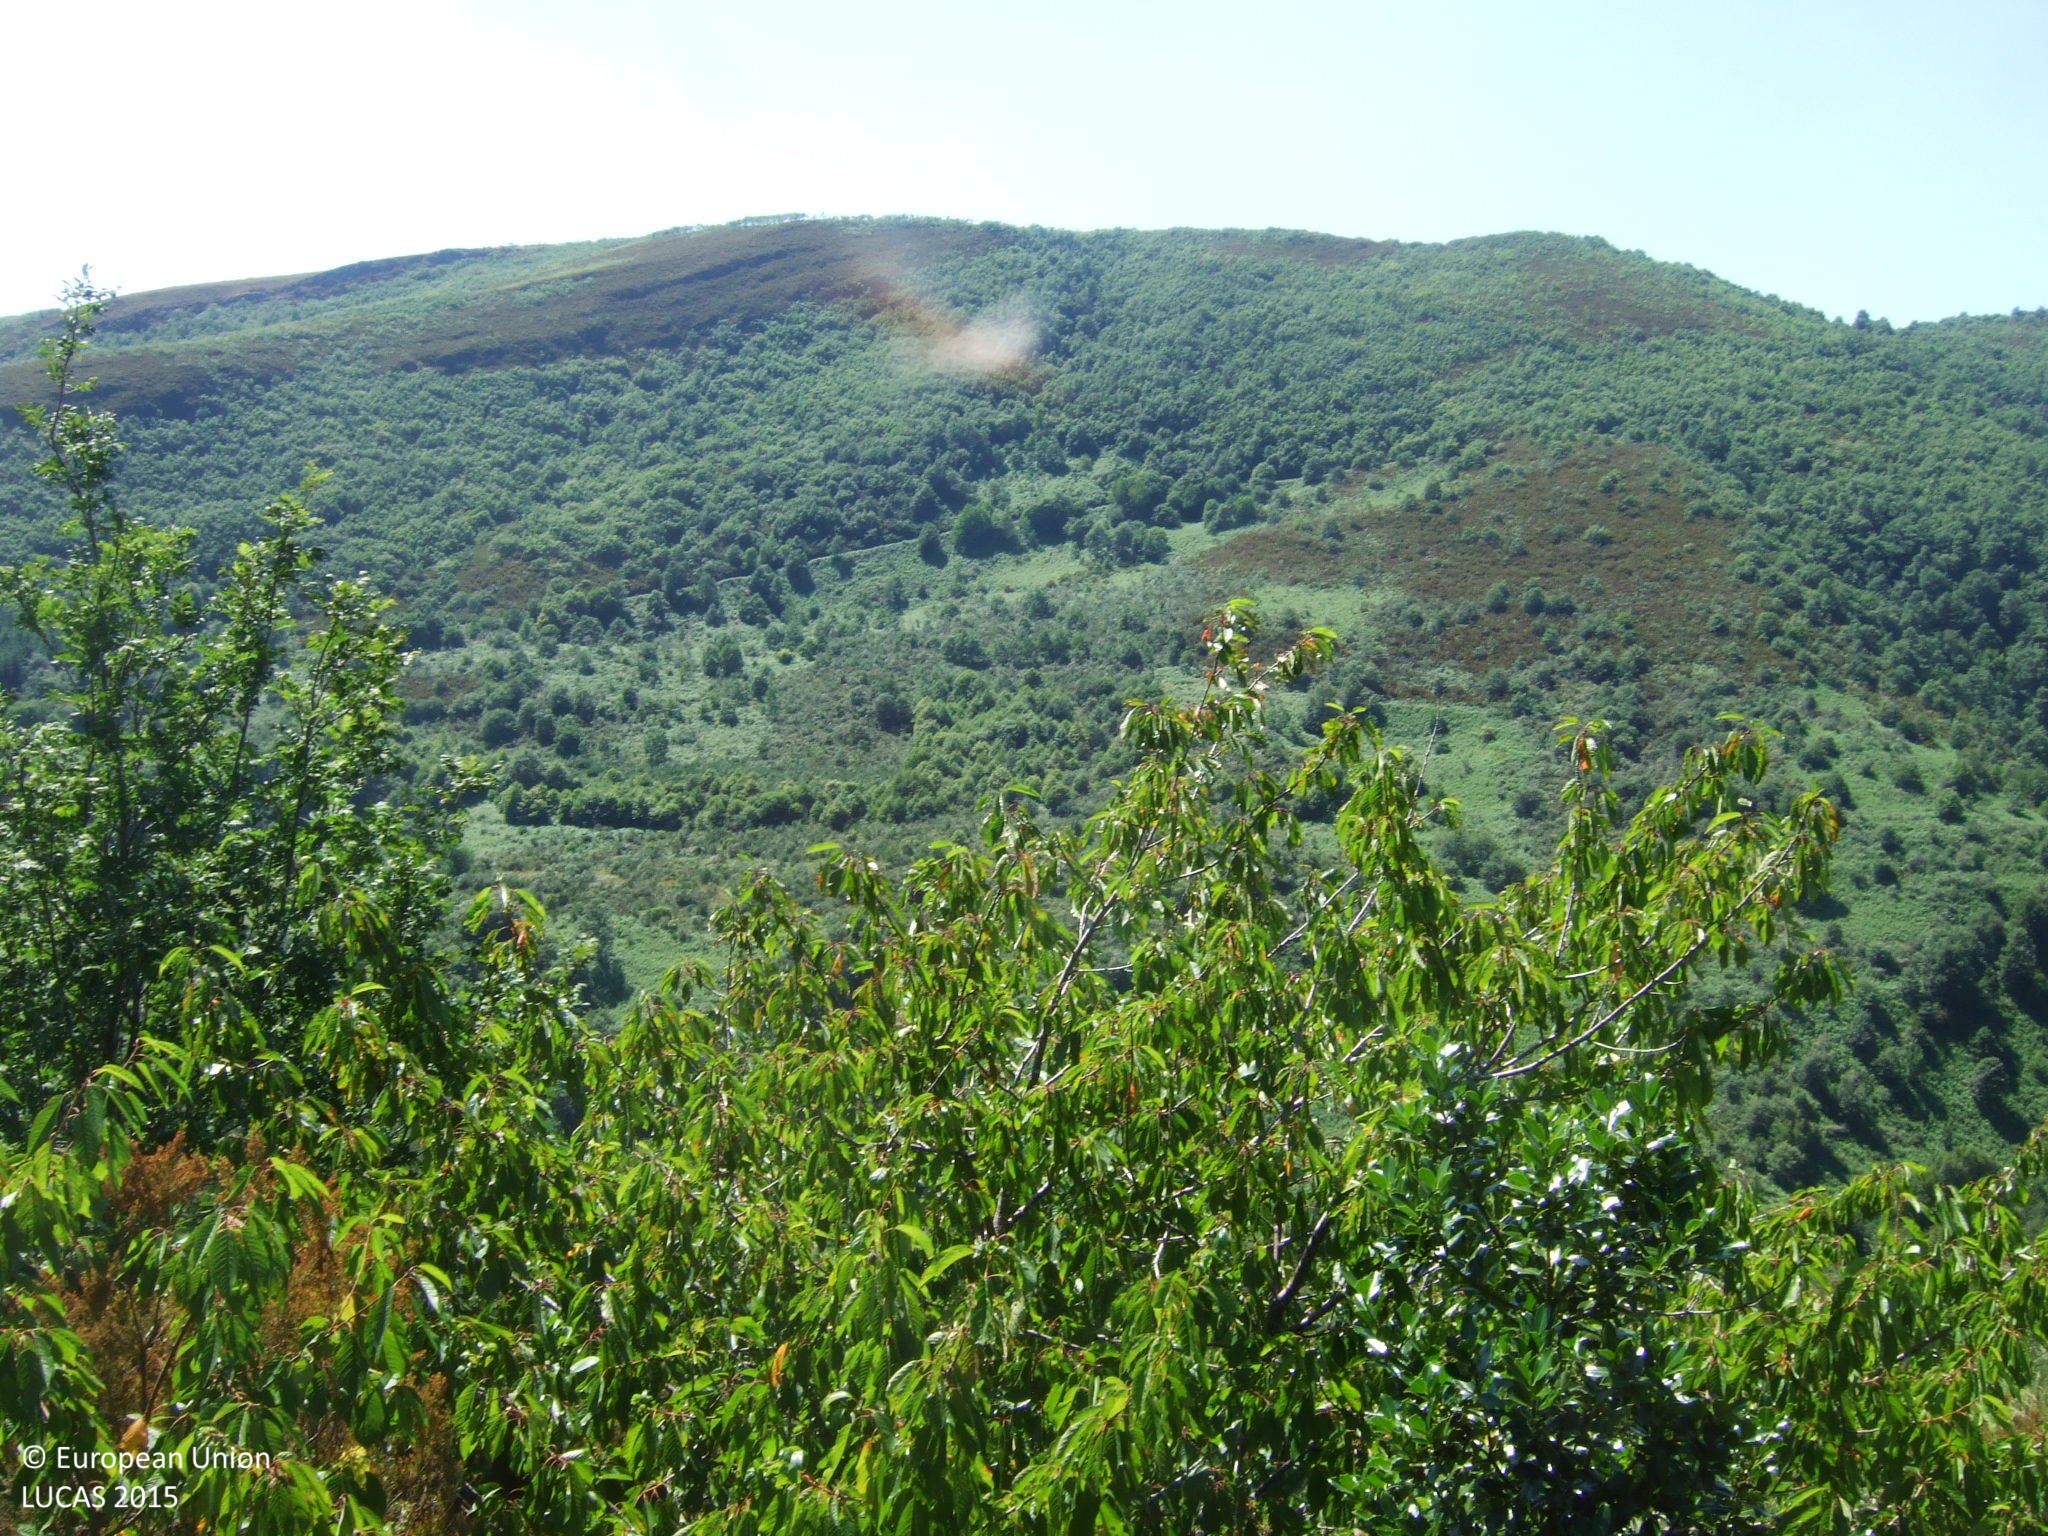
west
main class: Shrubland
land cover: Shrubland without tree cover
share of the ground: 50 - 75 %
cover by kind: shrubs 70 %, herbaceous plants 30 %
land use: Abandoned areas
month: June
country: ES
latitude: 42.8151
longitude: -6.9483
